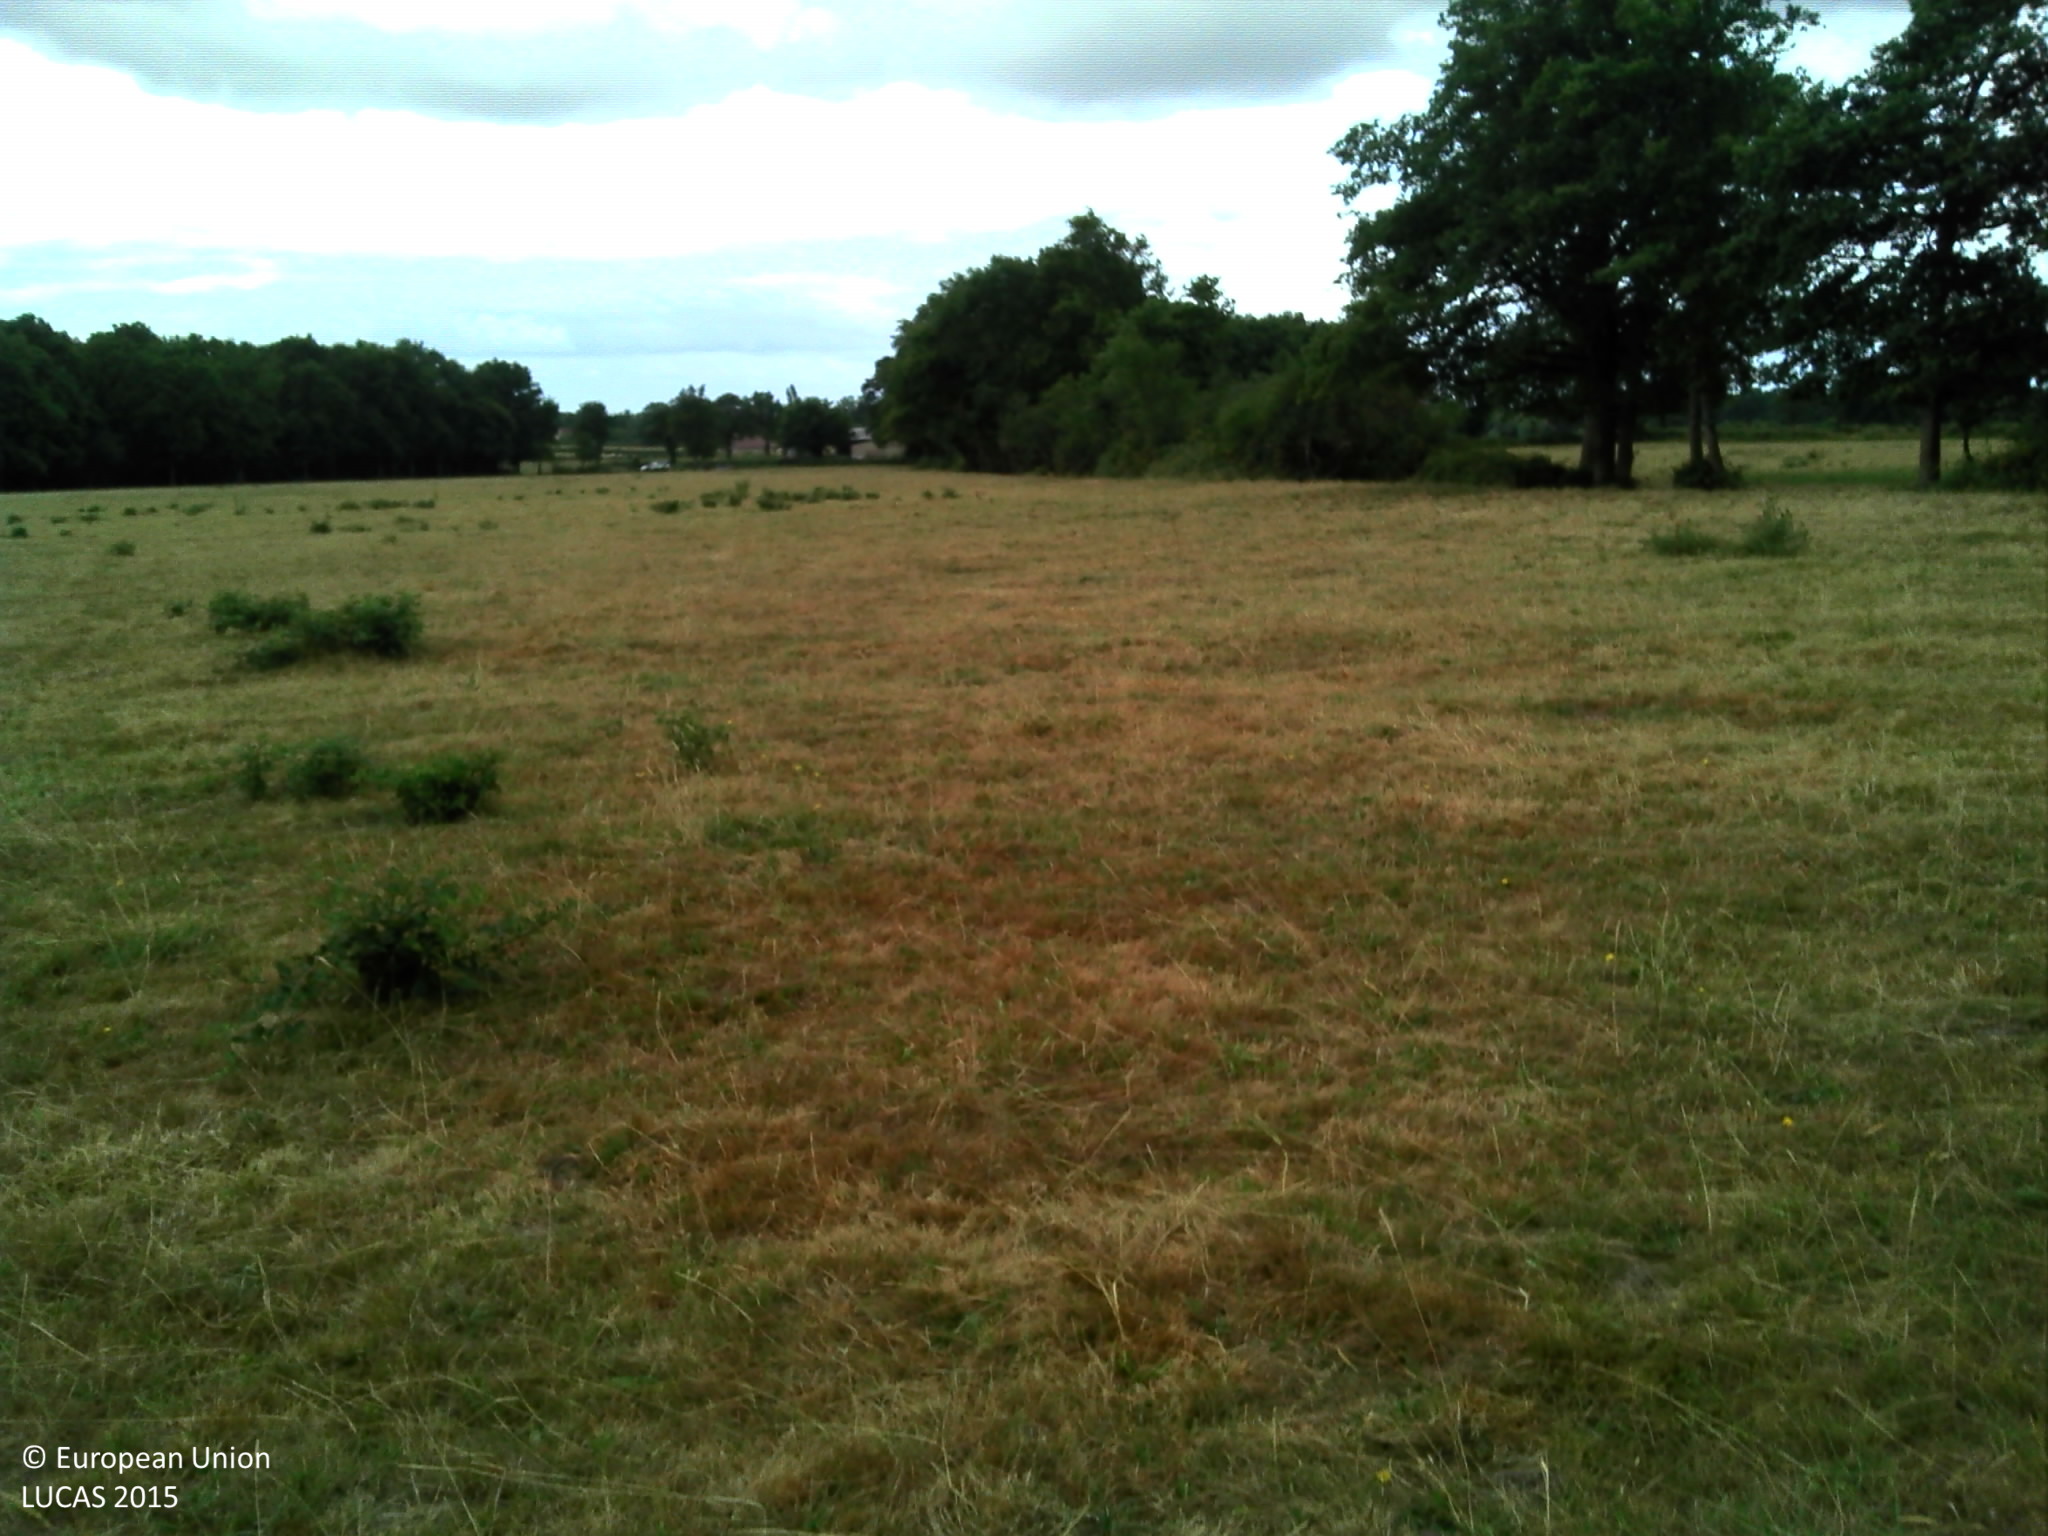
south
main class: Grassland
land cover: Grassland without tree/shrub cover
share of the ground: > 75 %
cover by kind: herbaceous plants 100 %
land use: Agriculture (excluding fallow land and kitchen gardens)
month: July
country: FR
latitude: 46.7493
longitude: 3.2034
